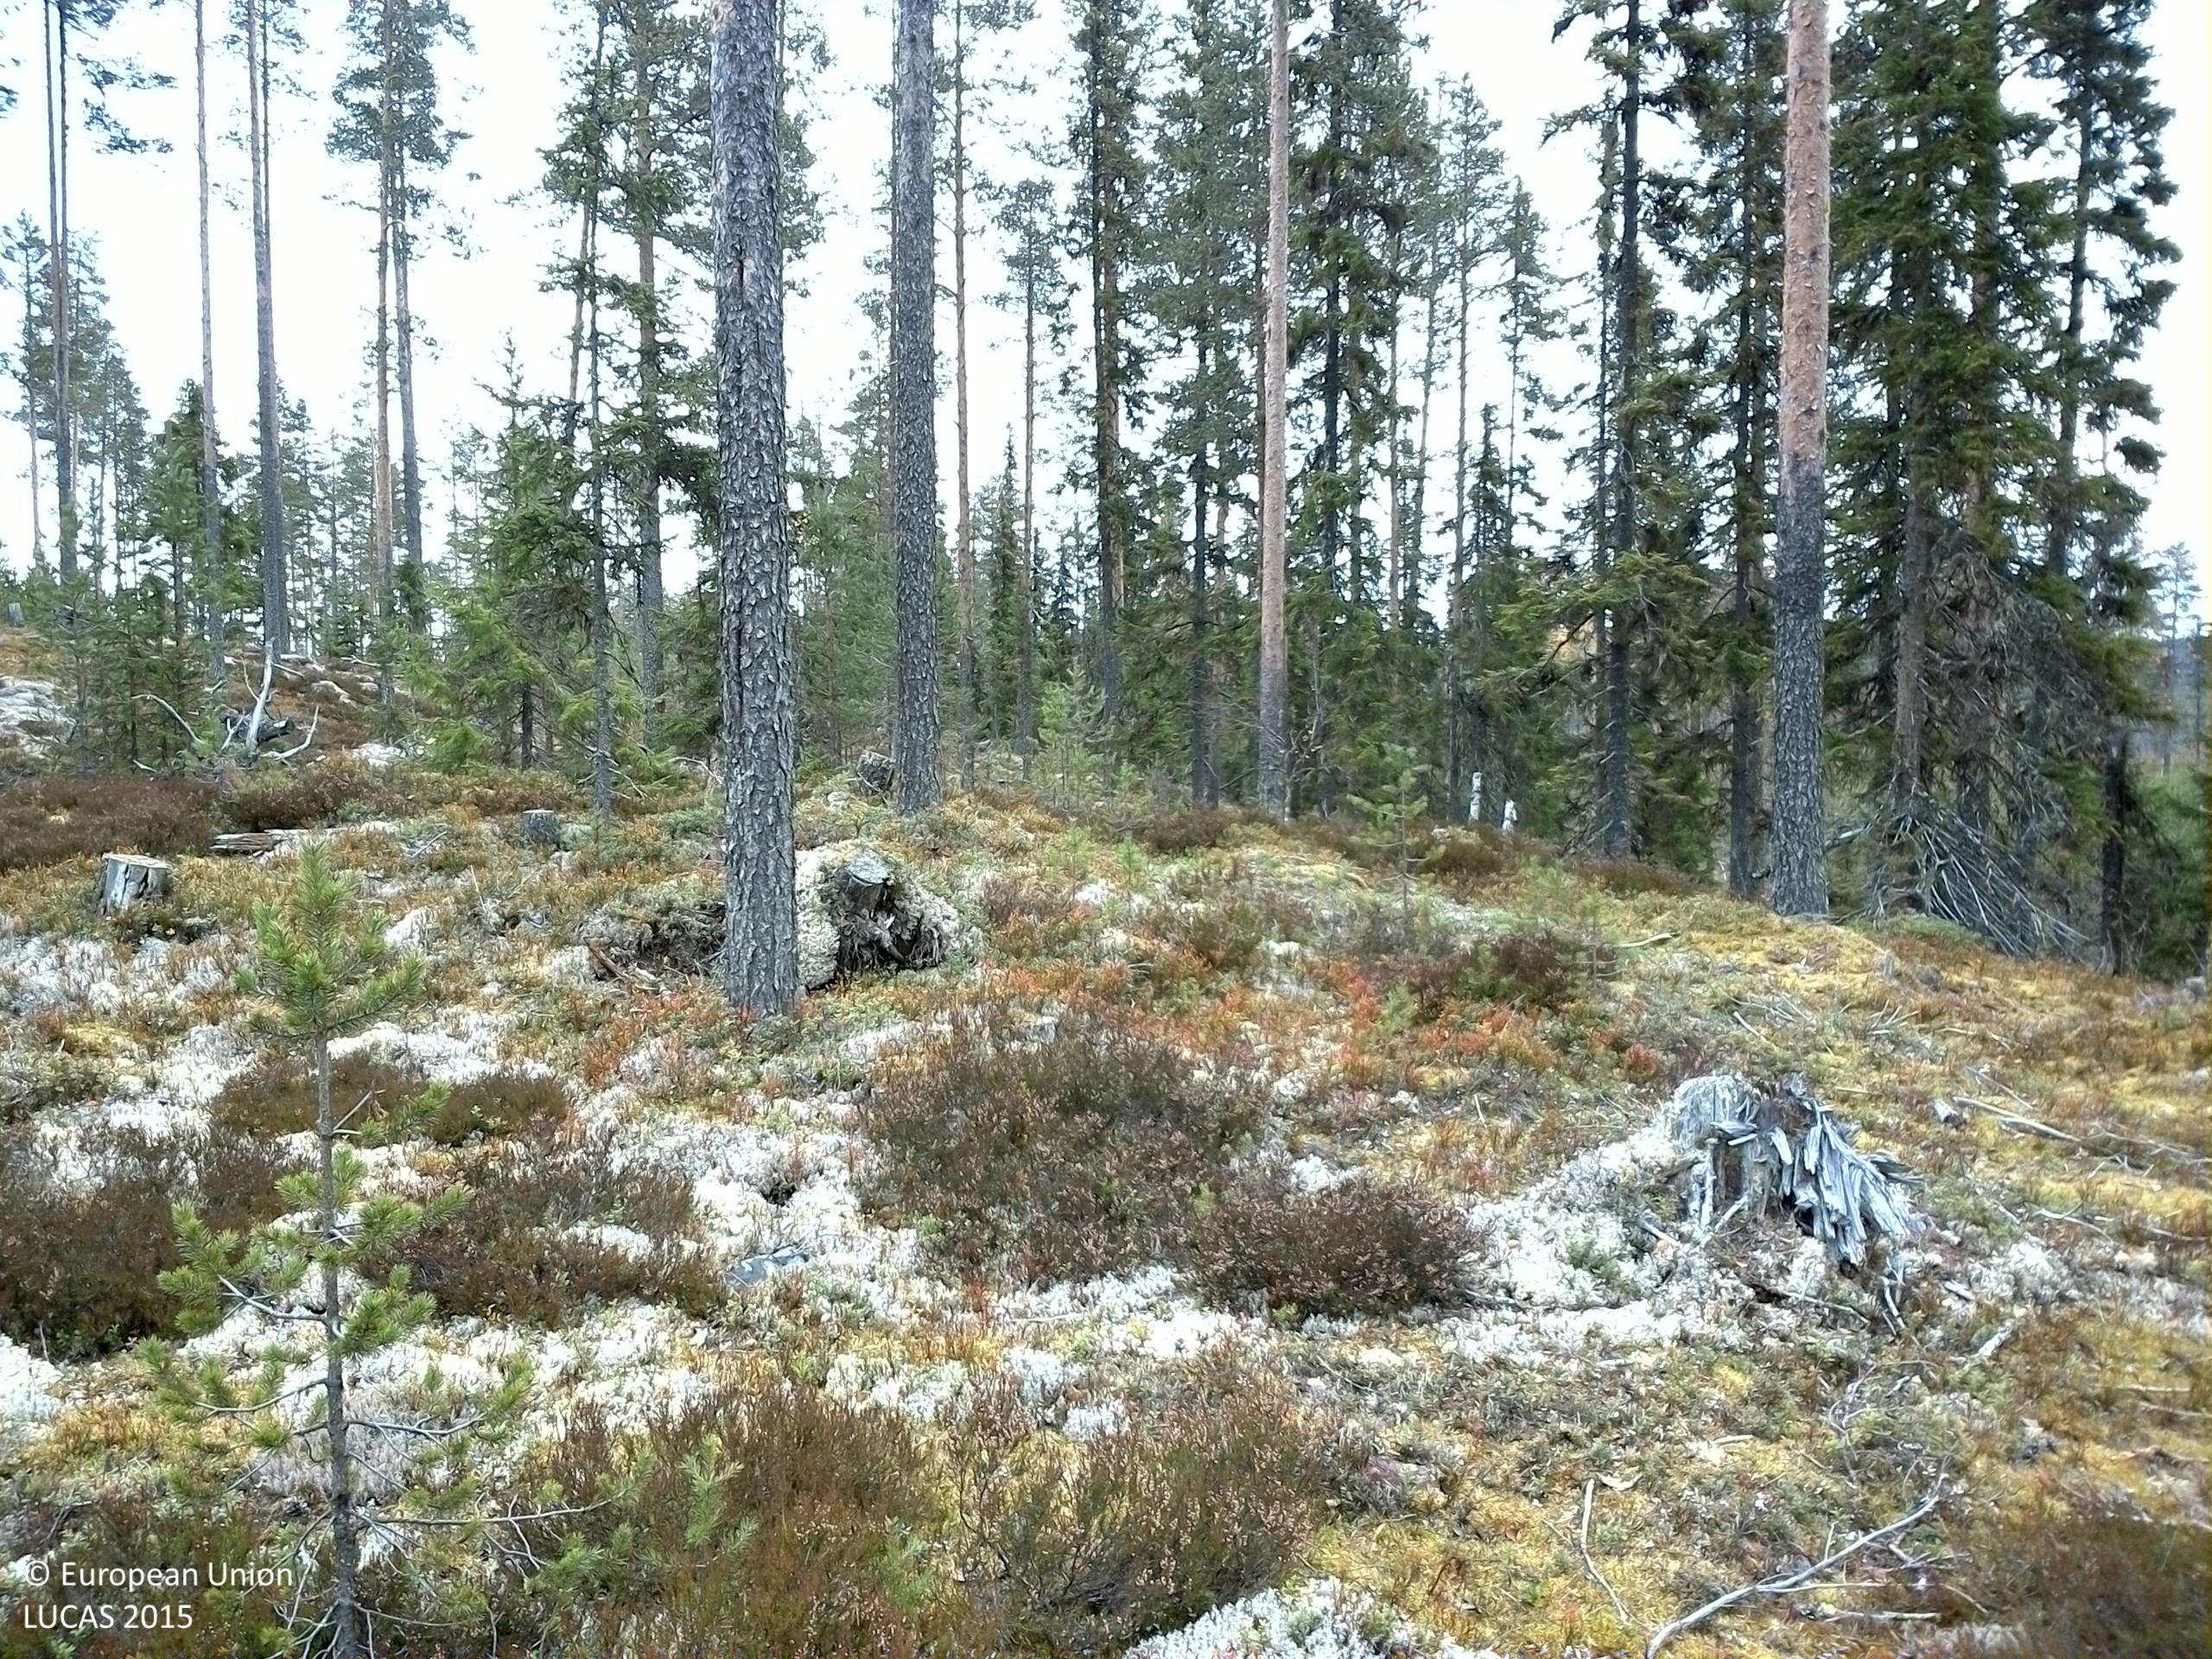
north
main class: Woodland
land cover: Pine dominated coniferous woodland
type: boreal forest
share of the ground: 25 - 50 %
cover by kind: shrubs 45 %, coniferous forest trees 35 %, lichens and mosses 20 %
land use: Forestry
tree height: > 5 m
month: October
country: SE
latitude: 61.5201
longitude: 14.3654
